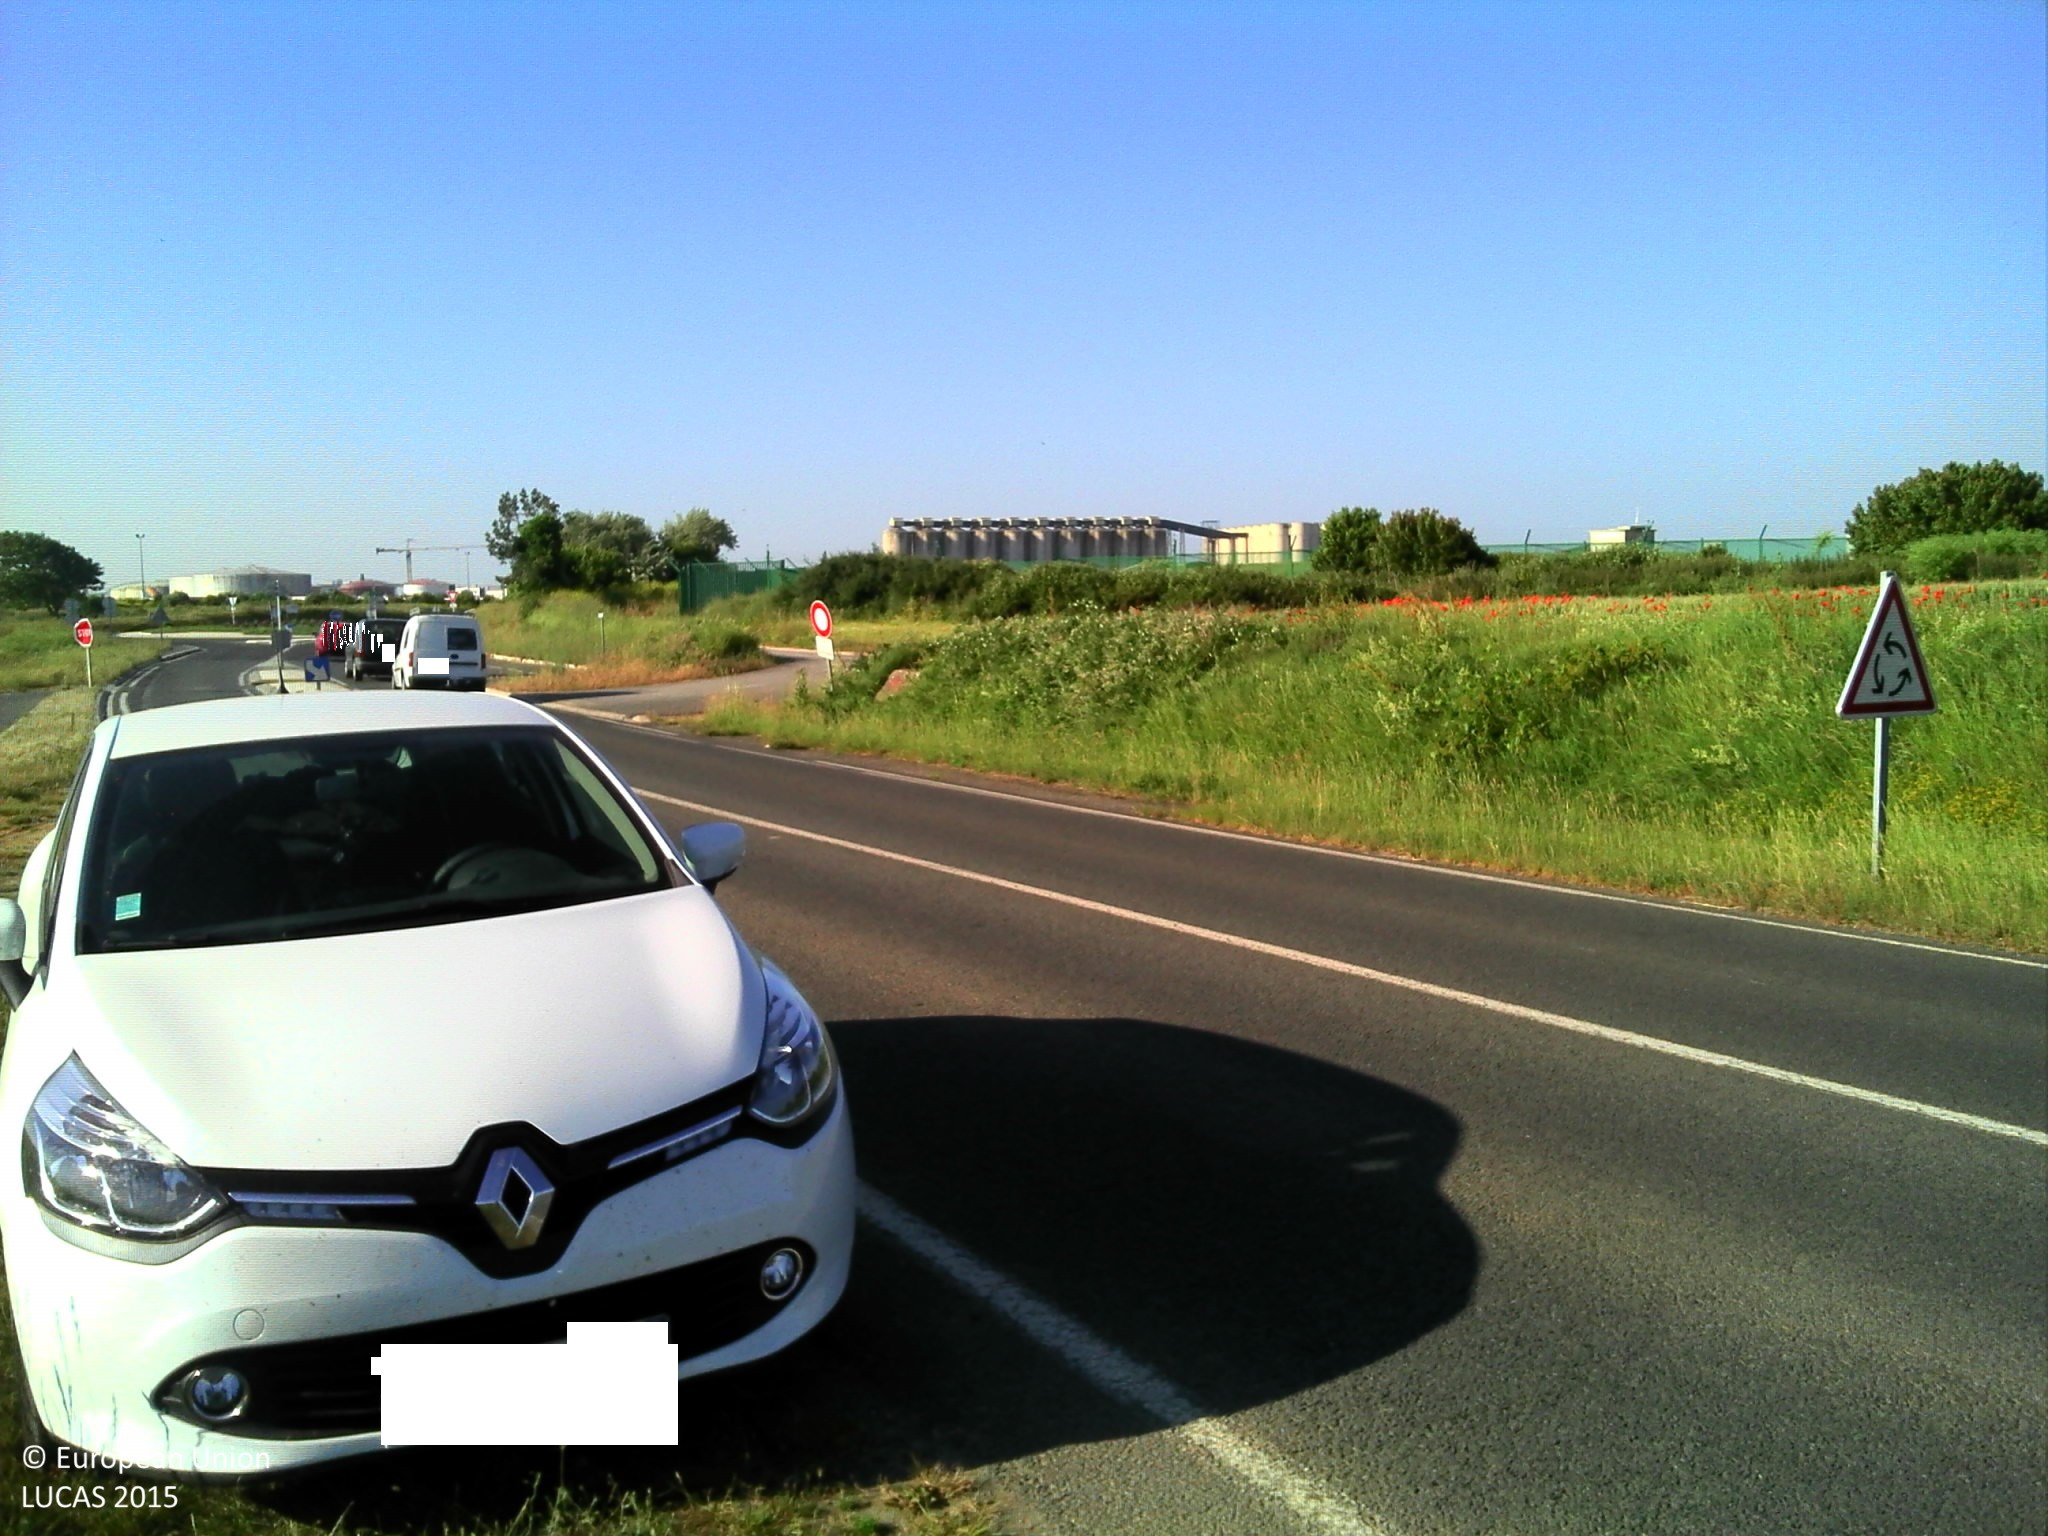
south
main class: Grassland
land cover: Spontaneously vegetated surfaces
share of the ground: > 75 %
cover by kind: herbaceous plants 95 %, shrubs 5 %
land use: Road transport
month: June
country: FR
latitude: 46.1778
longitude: -1.2119
